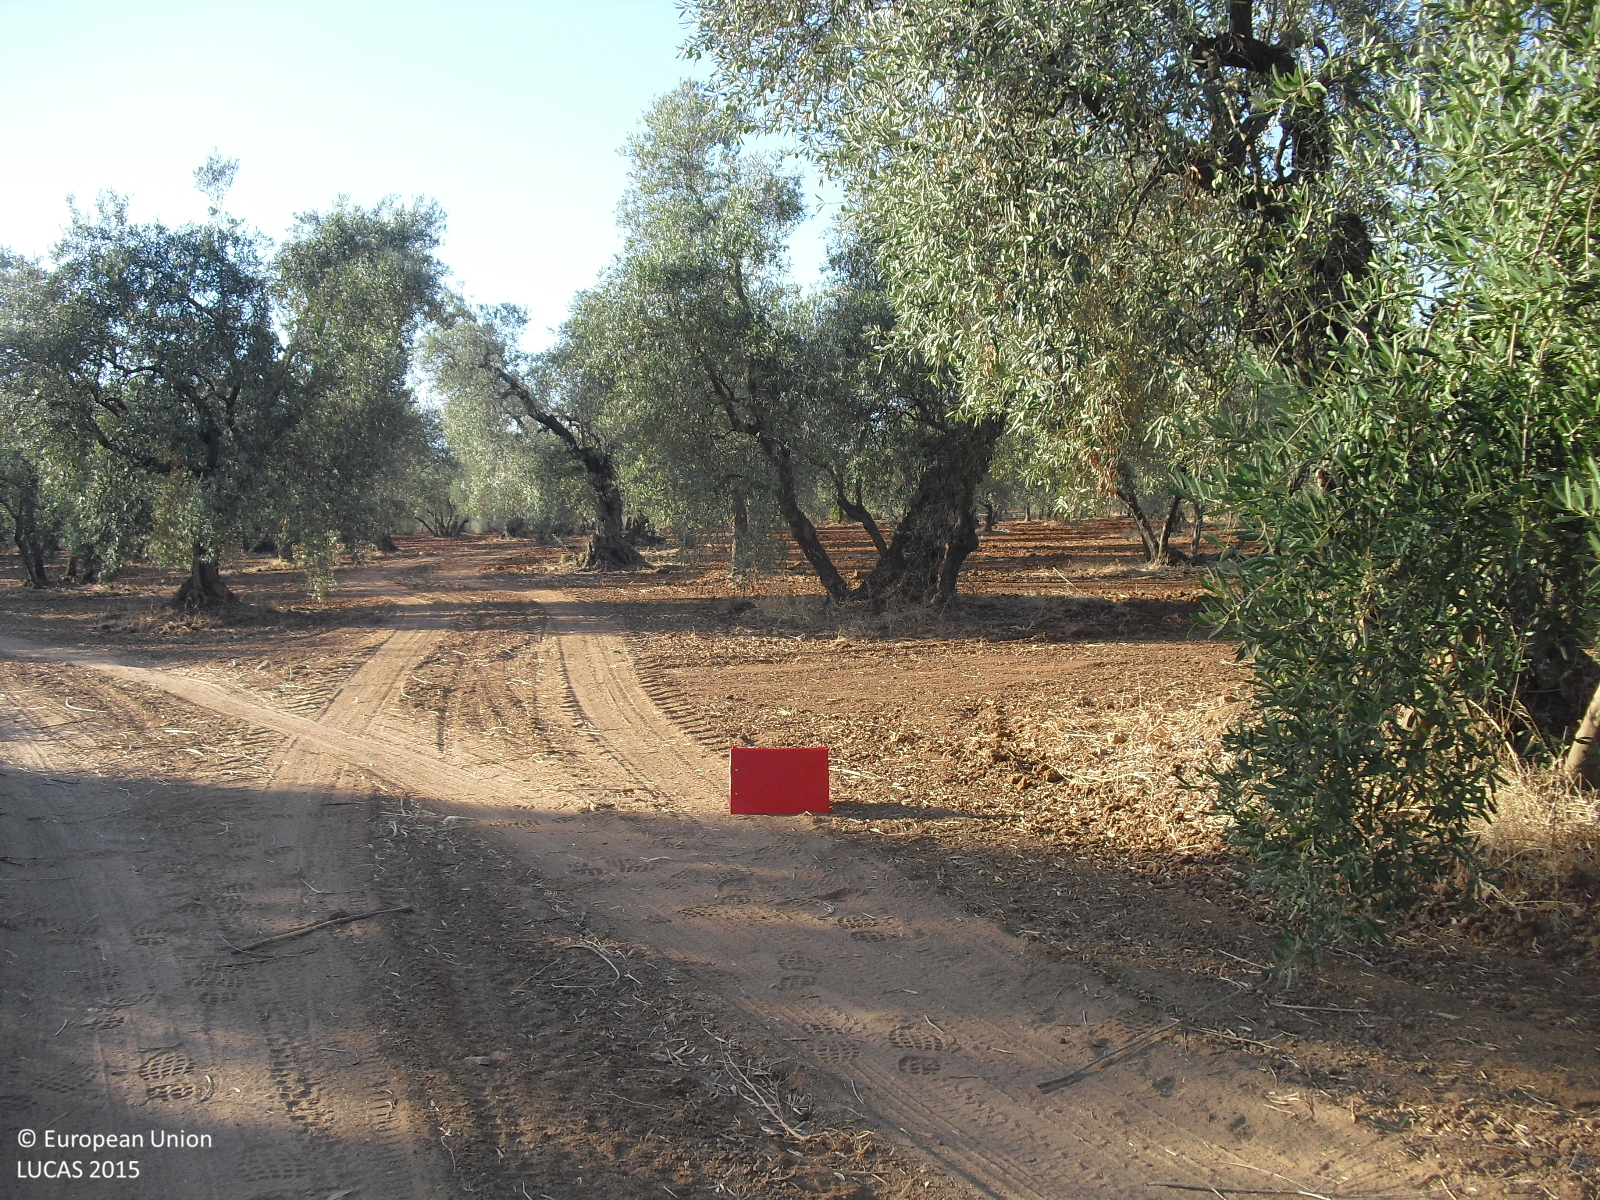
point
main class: Cropland
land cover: Olive groves
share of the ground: 25 - 50 %
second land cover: Other bare soil
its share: > 75 %
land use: Agriculture (excluding fallow land and kitchen gardens)
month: August
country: ES
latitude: 37.2007
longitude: -5.5271
